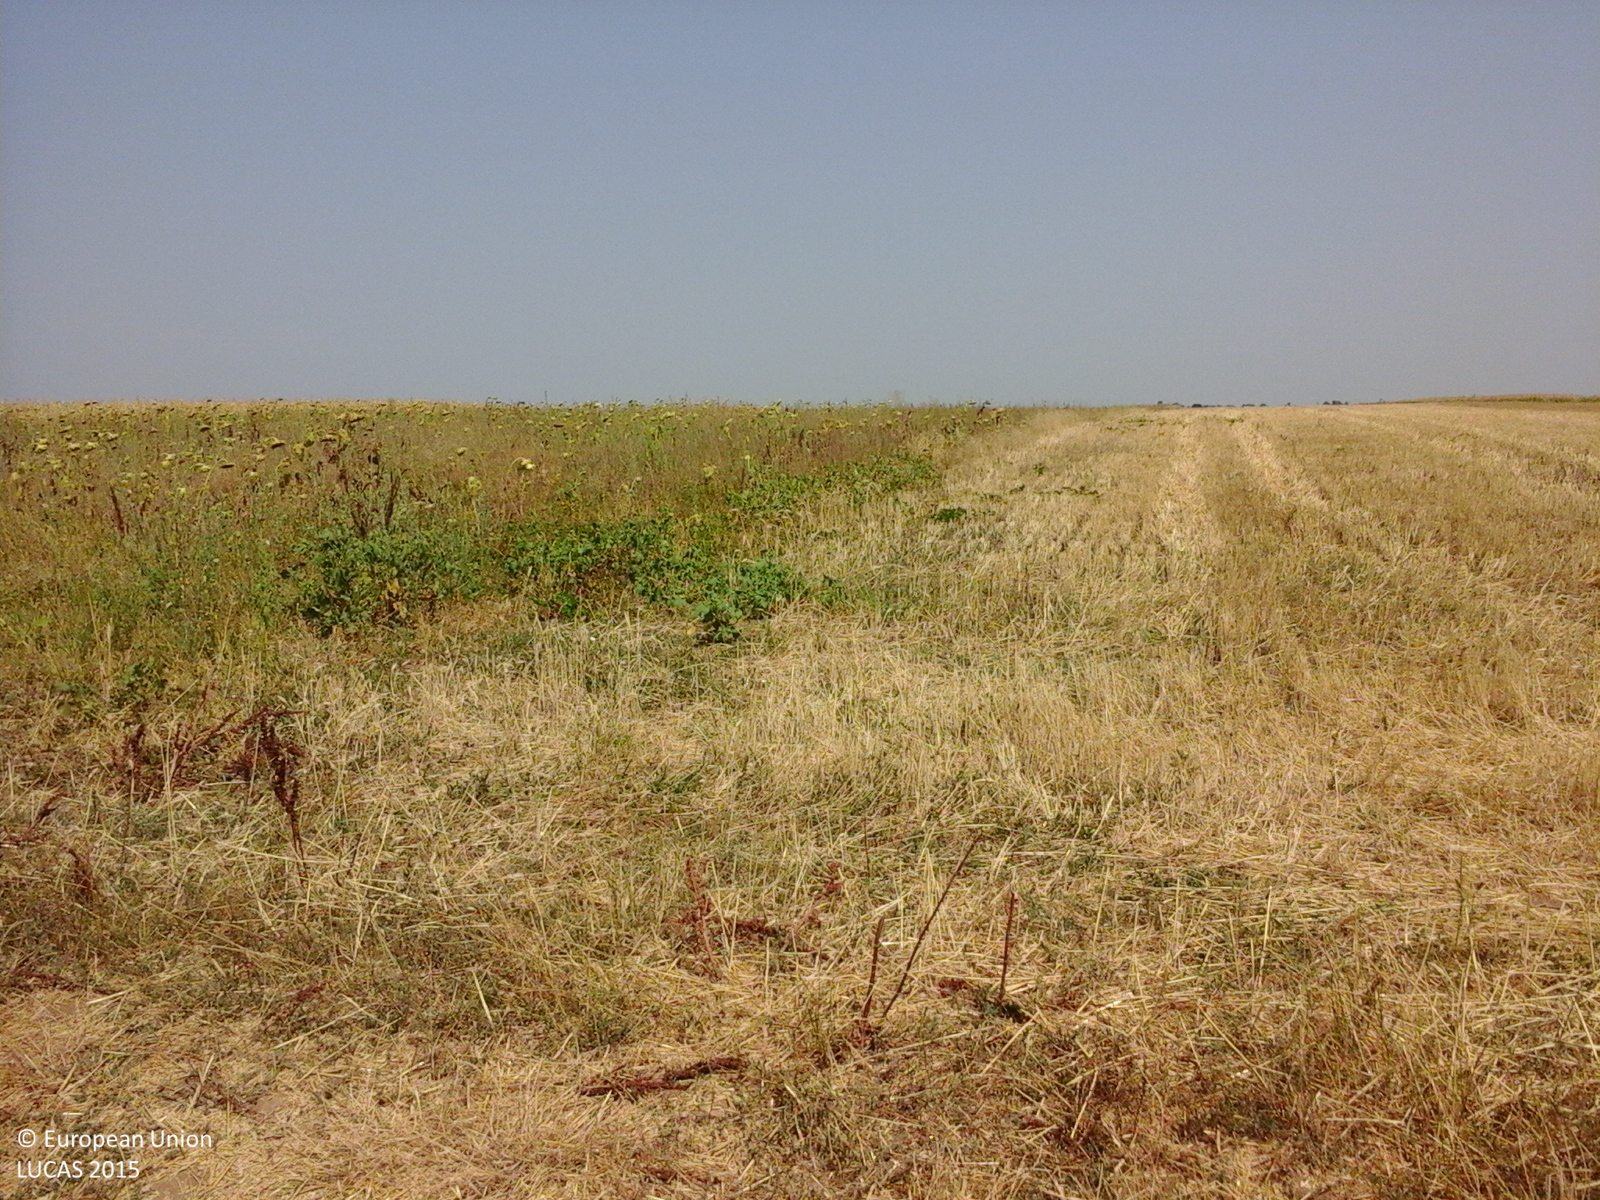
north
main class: Cropland
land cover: Sunflower
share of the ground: > 75 %
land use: Agriculture (excluding fallow land and kitchen gardens)
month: August
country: RO
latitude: 44.2650
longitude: 23.2379
